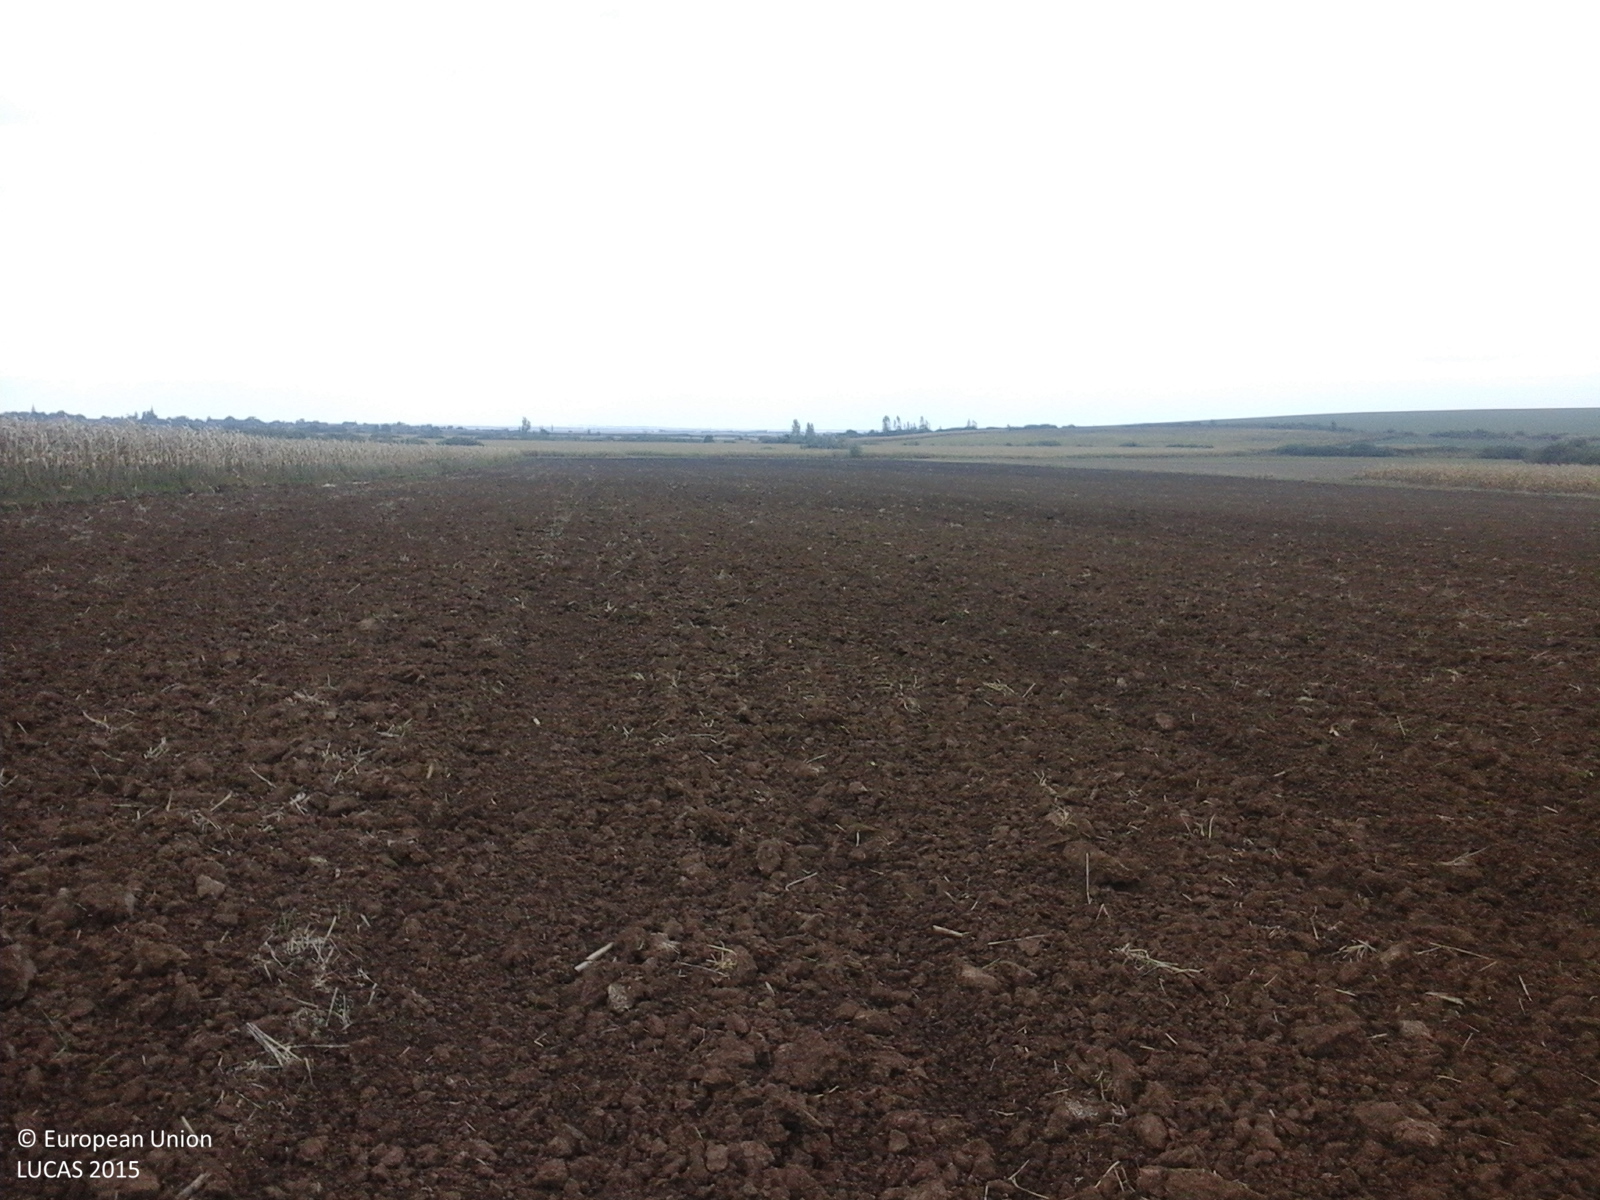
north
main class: Cropland
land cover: Common wheat
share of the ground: < 10 %
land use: Agriculture (excluding fallow land and kitchen gardens)
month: September
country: RO
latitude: 47.4766
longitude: 22.4631
